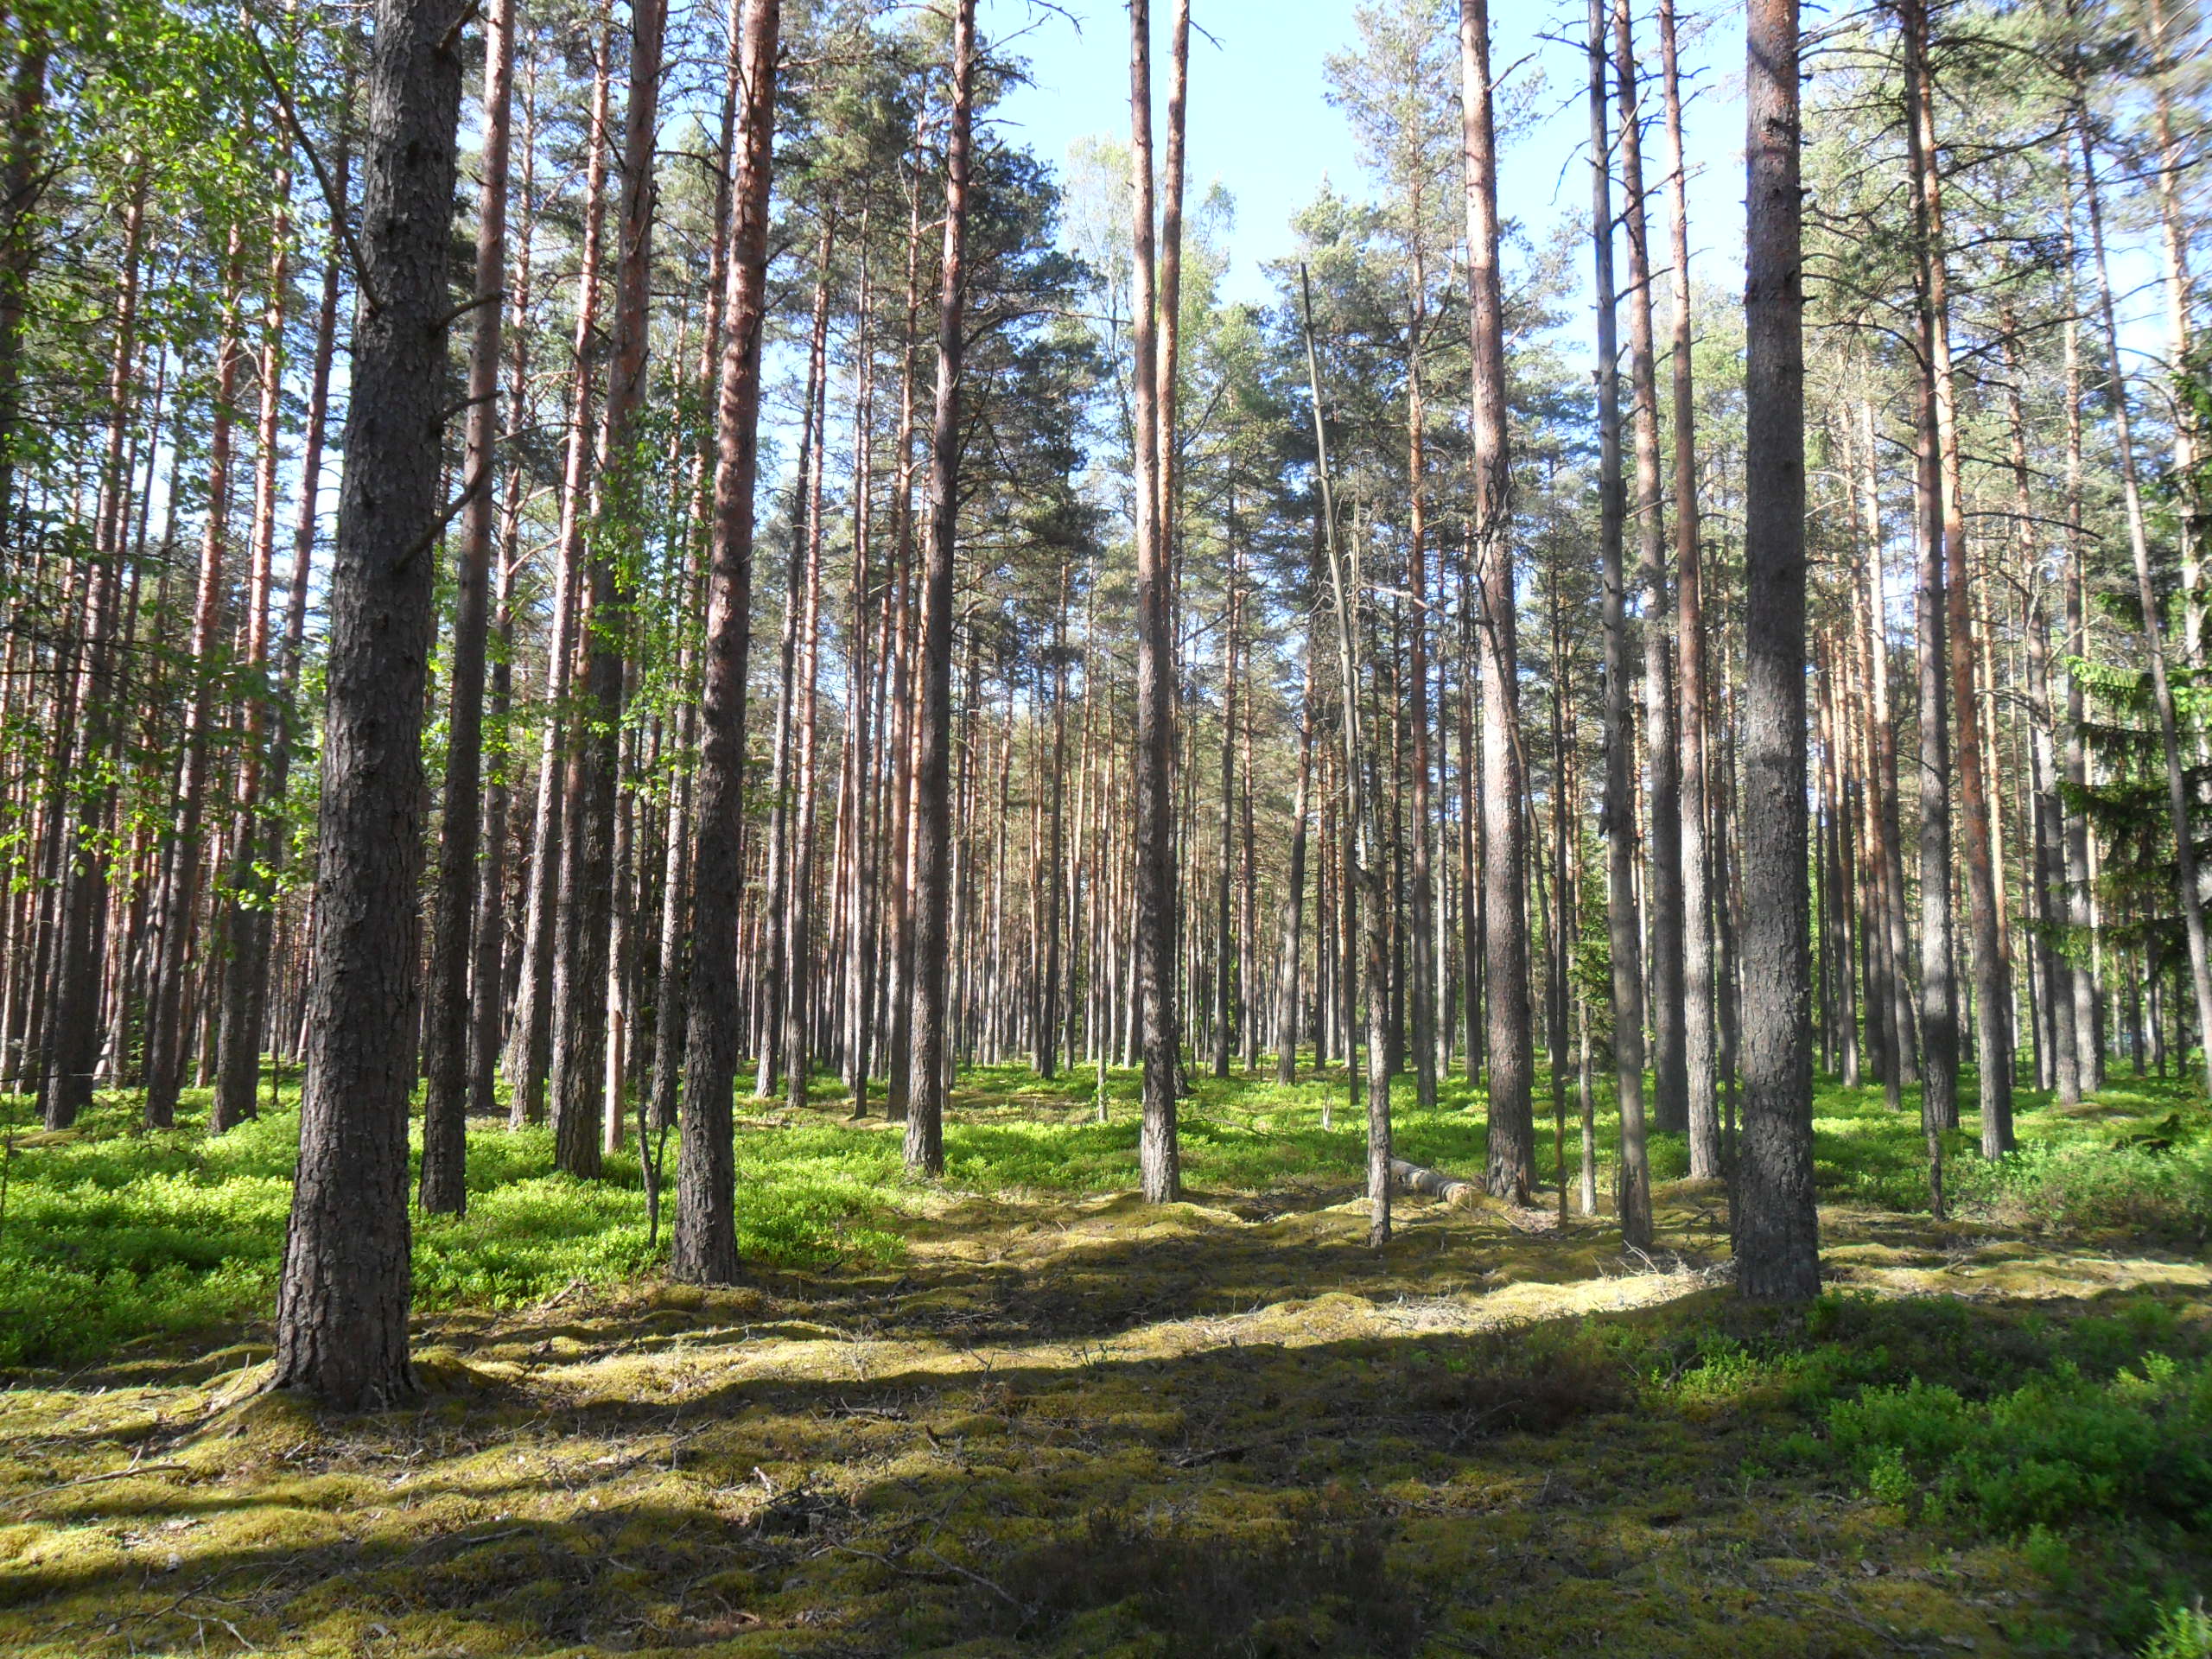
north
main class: Woodland
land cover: Pine dominated coniferous woodland
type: hemiboreal forest and nemoral coniferous forest and mixed broadleaved-coniferous forest
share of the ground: > 75 %
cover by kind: coniferous forest trees 90 %, herbaceous plants 10 %
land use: Forestry
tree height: > 5 m
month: June
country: LV
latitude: 57.5667
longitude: 22.2355
